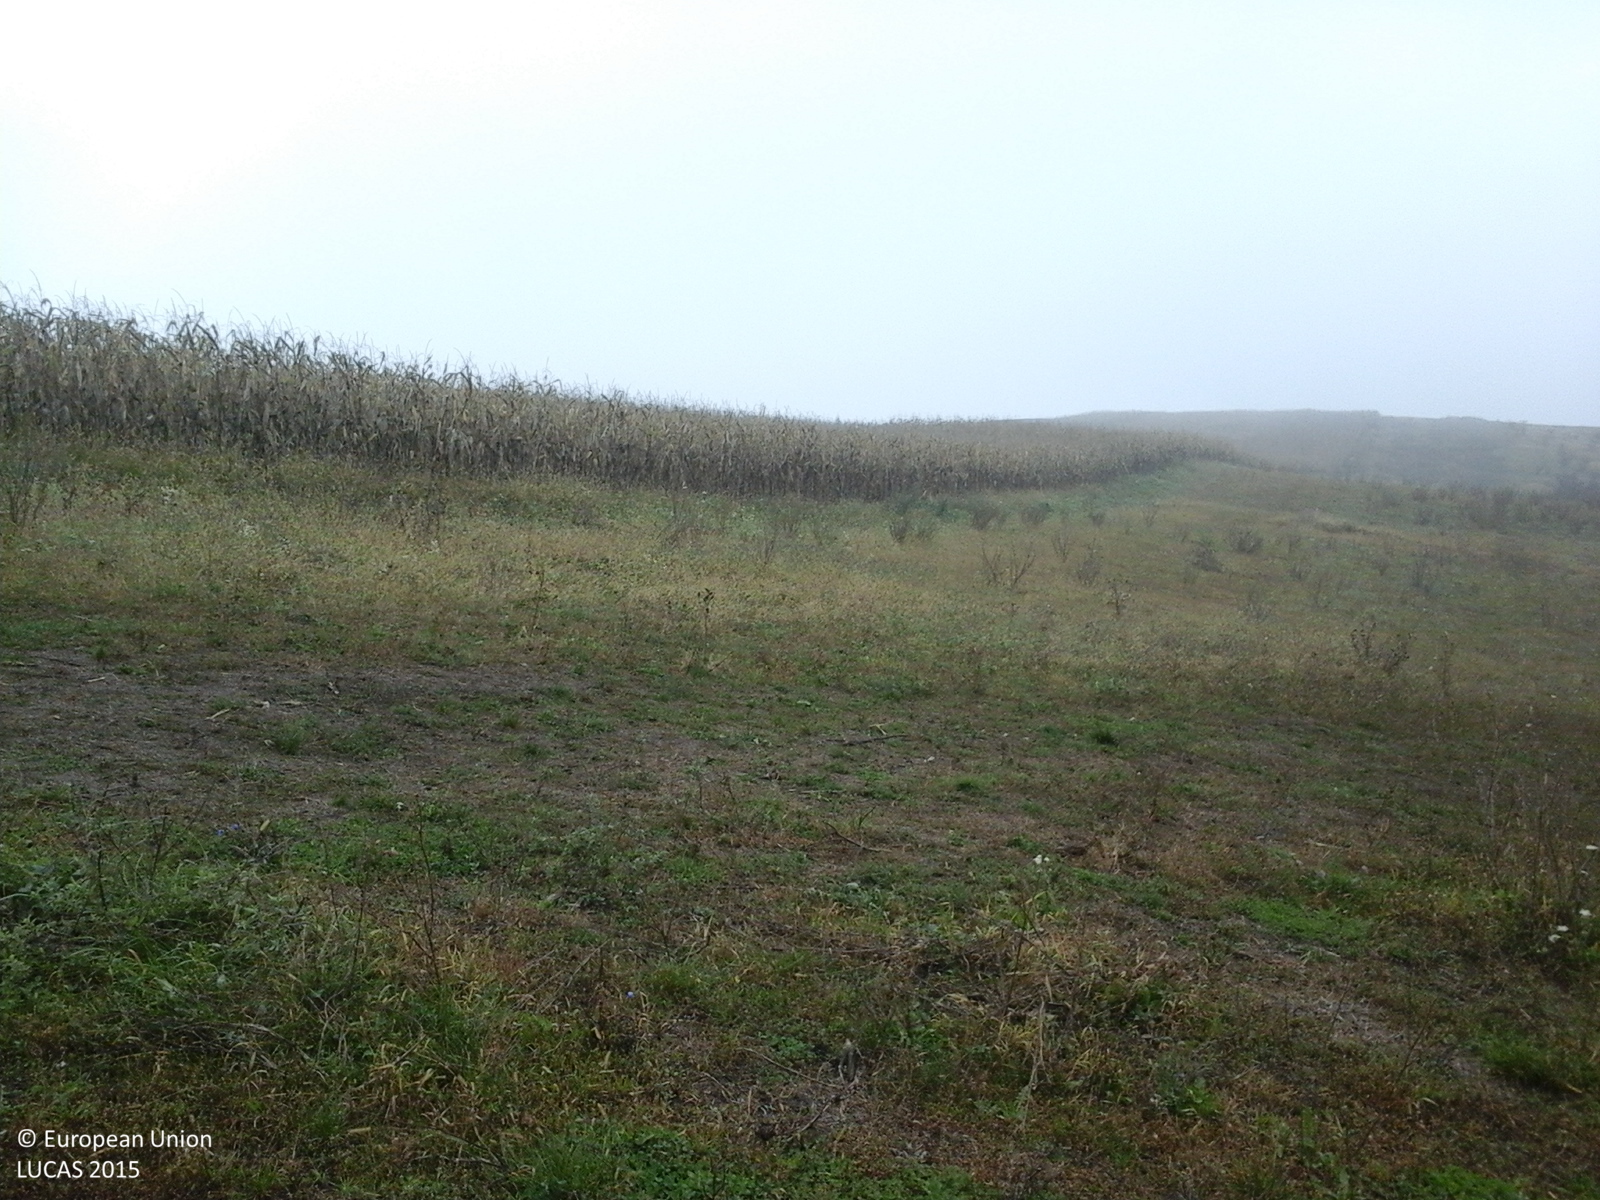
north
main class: Grassland
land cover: Spontaneously vegetated surfaces
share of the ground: > 75 %
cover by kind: herbaceous plants 100 %
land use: Agriculture (excluding fallow land and kitchen gardens)
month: October
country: RO
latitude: 46.6843
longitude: 23.8692
